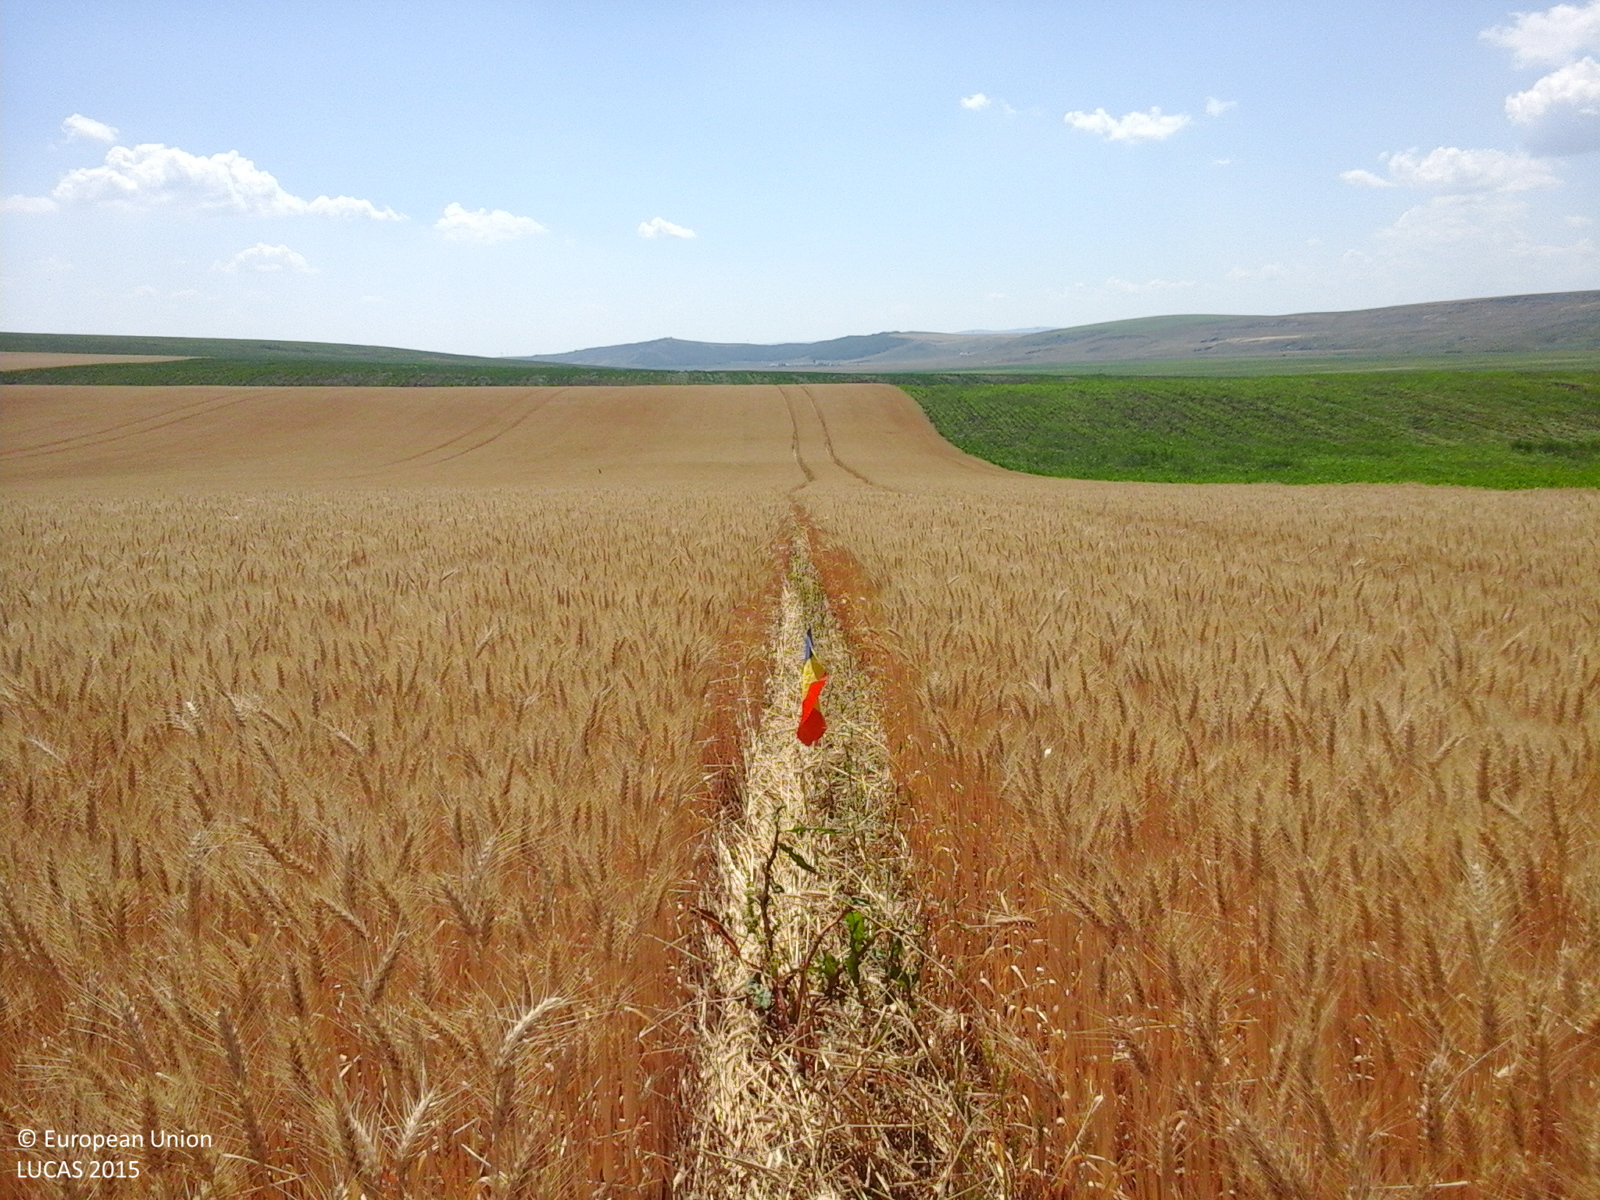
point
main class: Cropland
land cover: Common wheat
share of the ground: > 75 %
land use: Agriculture (excluding fallow land and kitchen gardens)
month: June
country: RO
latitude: 47.2891
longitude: 27.1499
